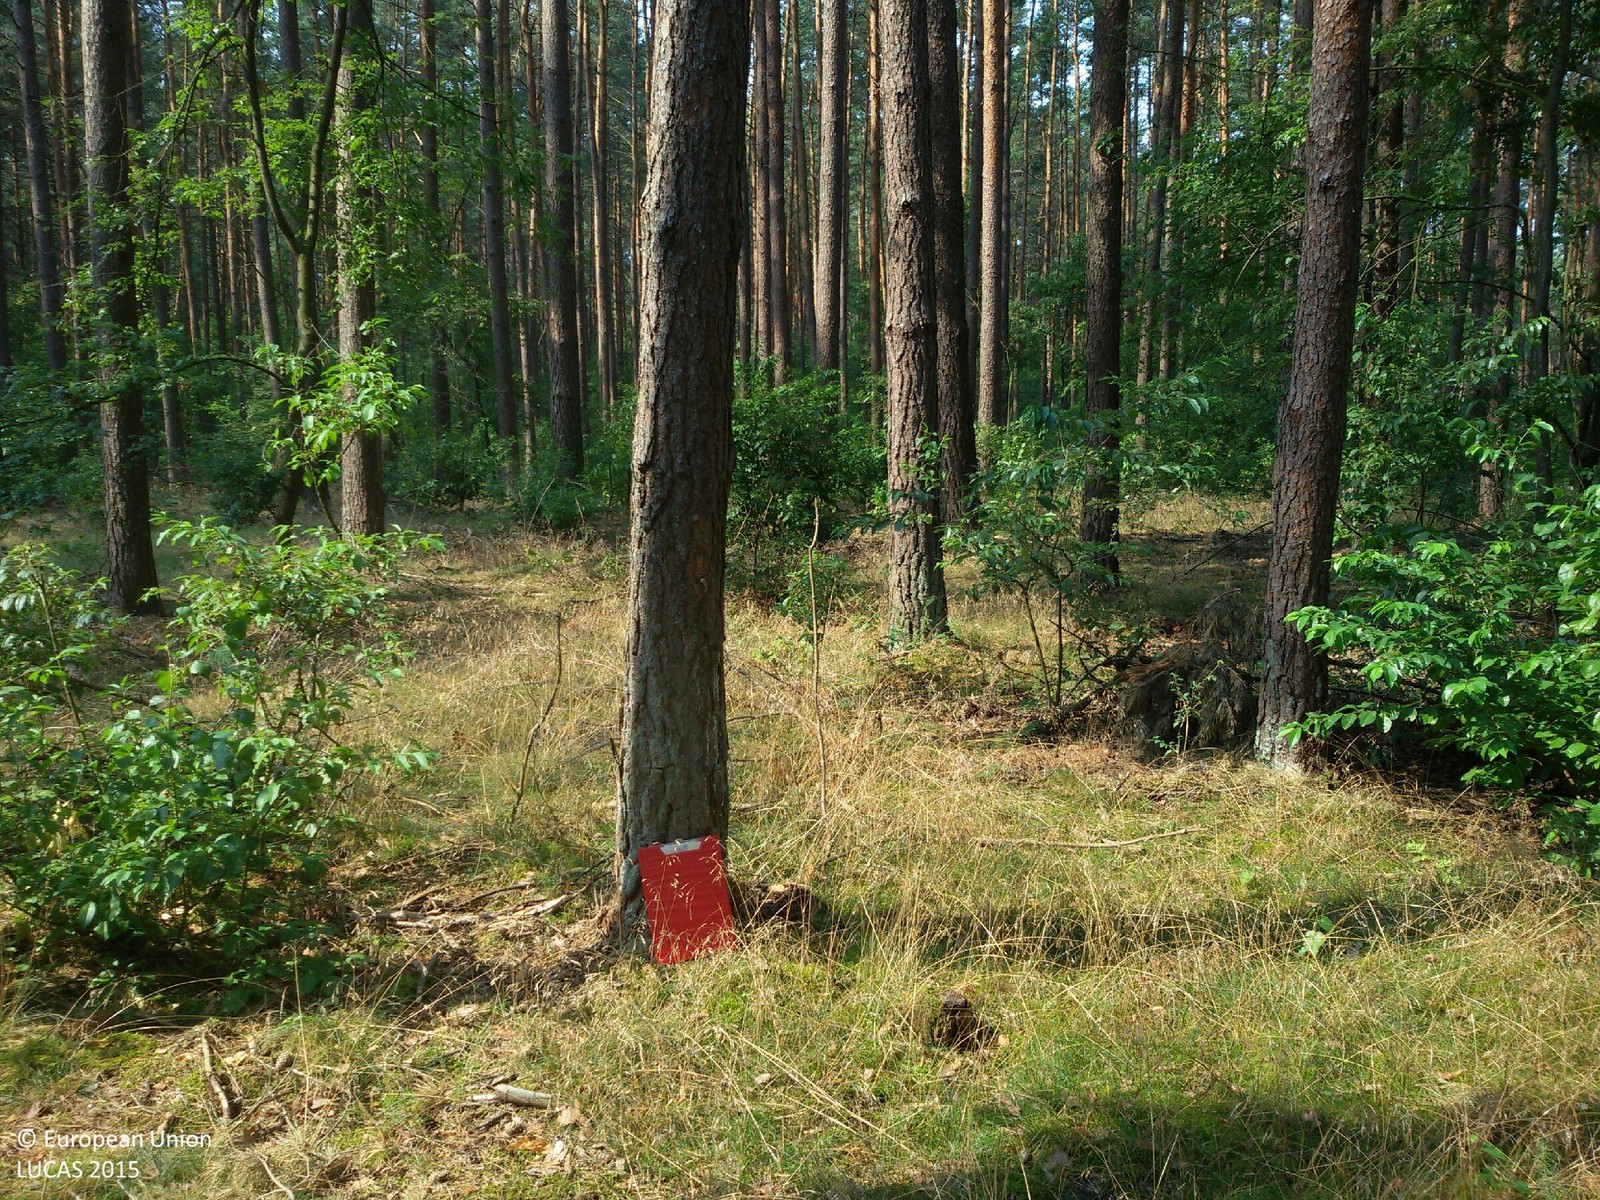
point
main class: Woodland
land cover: Pine dominated coniferous woodland
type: hemiboreal forest and nemoral coniferous forest and mixed broadleaved-coniferous forest
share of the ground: > 75 %
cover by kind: coniferous forest trees 90 %, shrubs 5 %, herbaceous plants 5 %
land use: Forestry
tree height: > 5 m
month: August
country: PL
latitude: 52.8301
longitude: 14.5581
